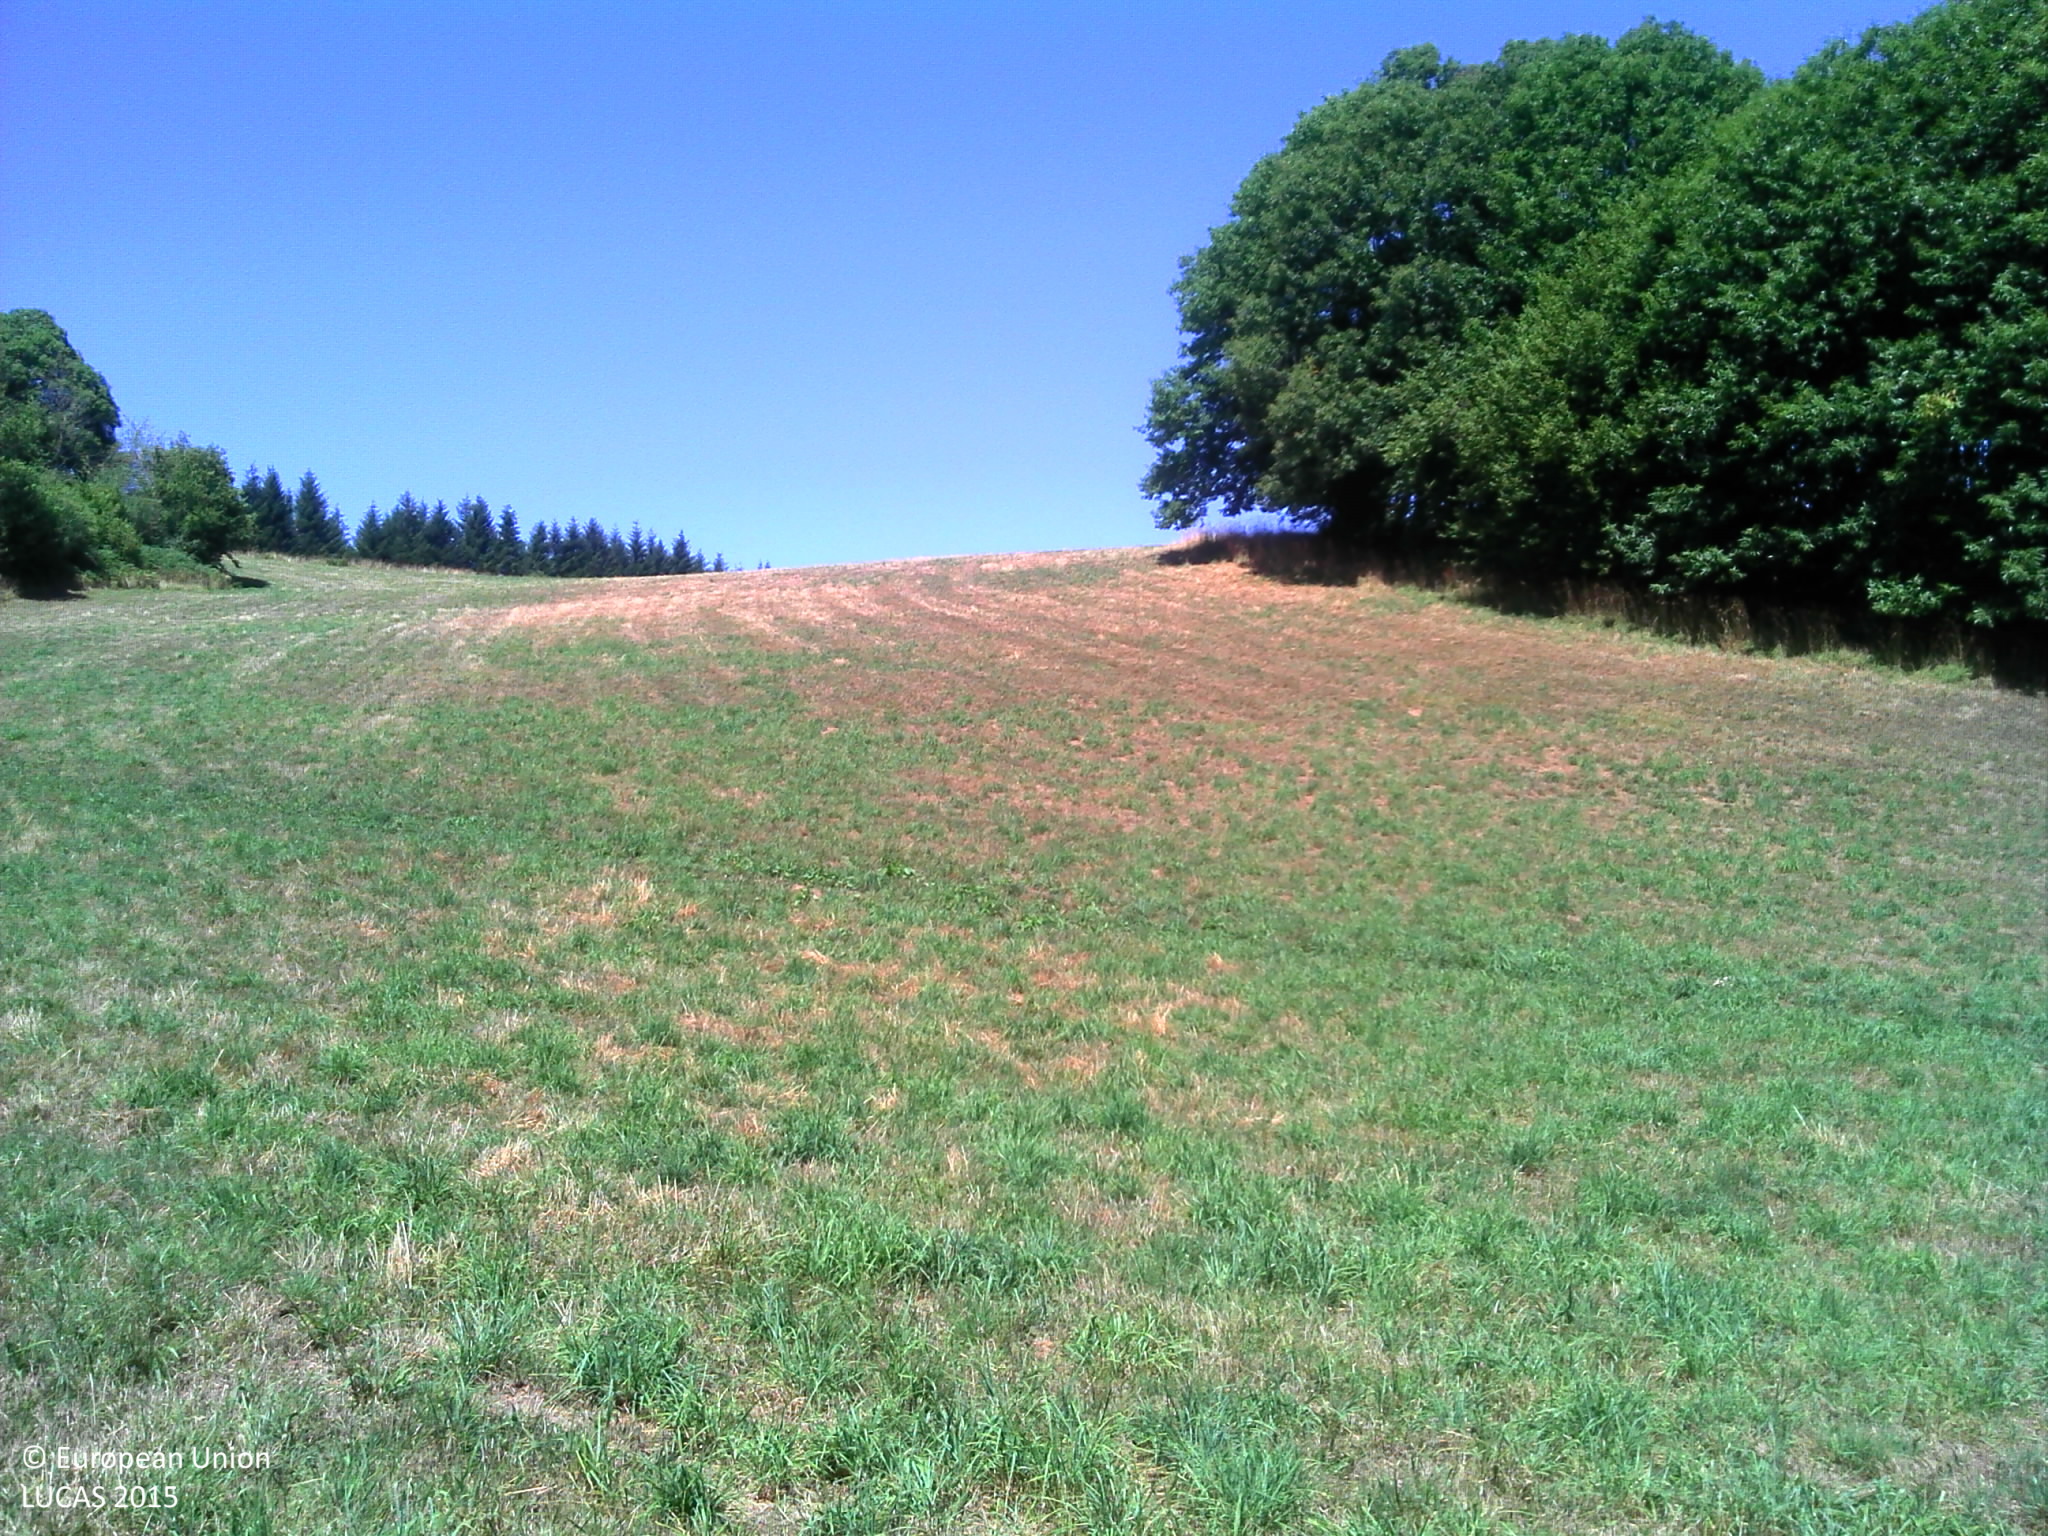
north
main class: Grassland
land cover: Grassland without tree/shrub cover
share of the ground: > 75 %
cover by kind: herbaceous plants 95 %
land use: Agriculture (excluding fallow land and kitchen gardens)
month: July
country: FR
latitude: 45.6255
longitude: 1.6441
